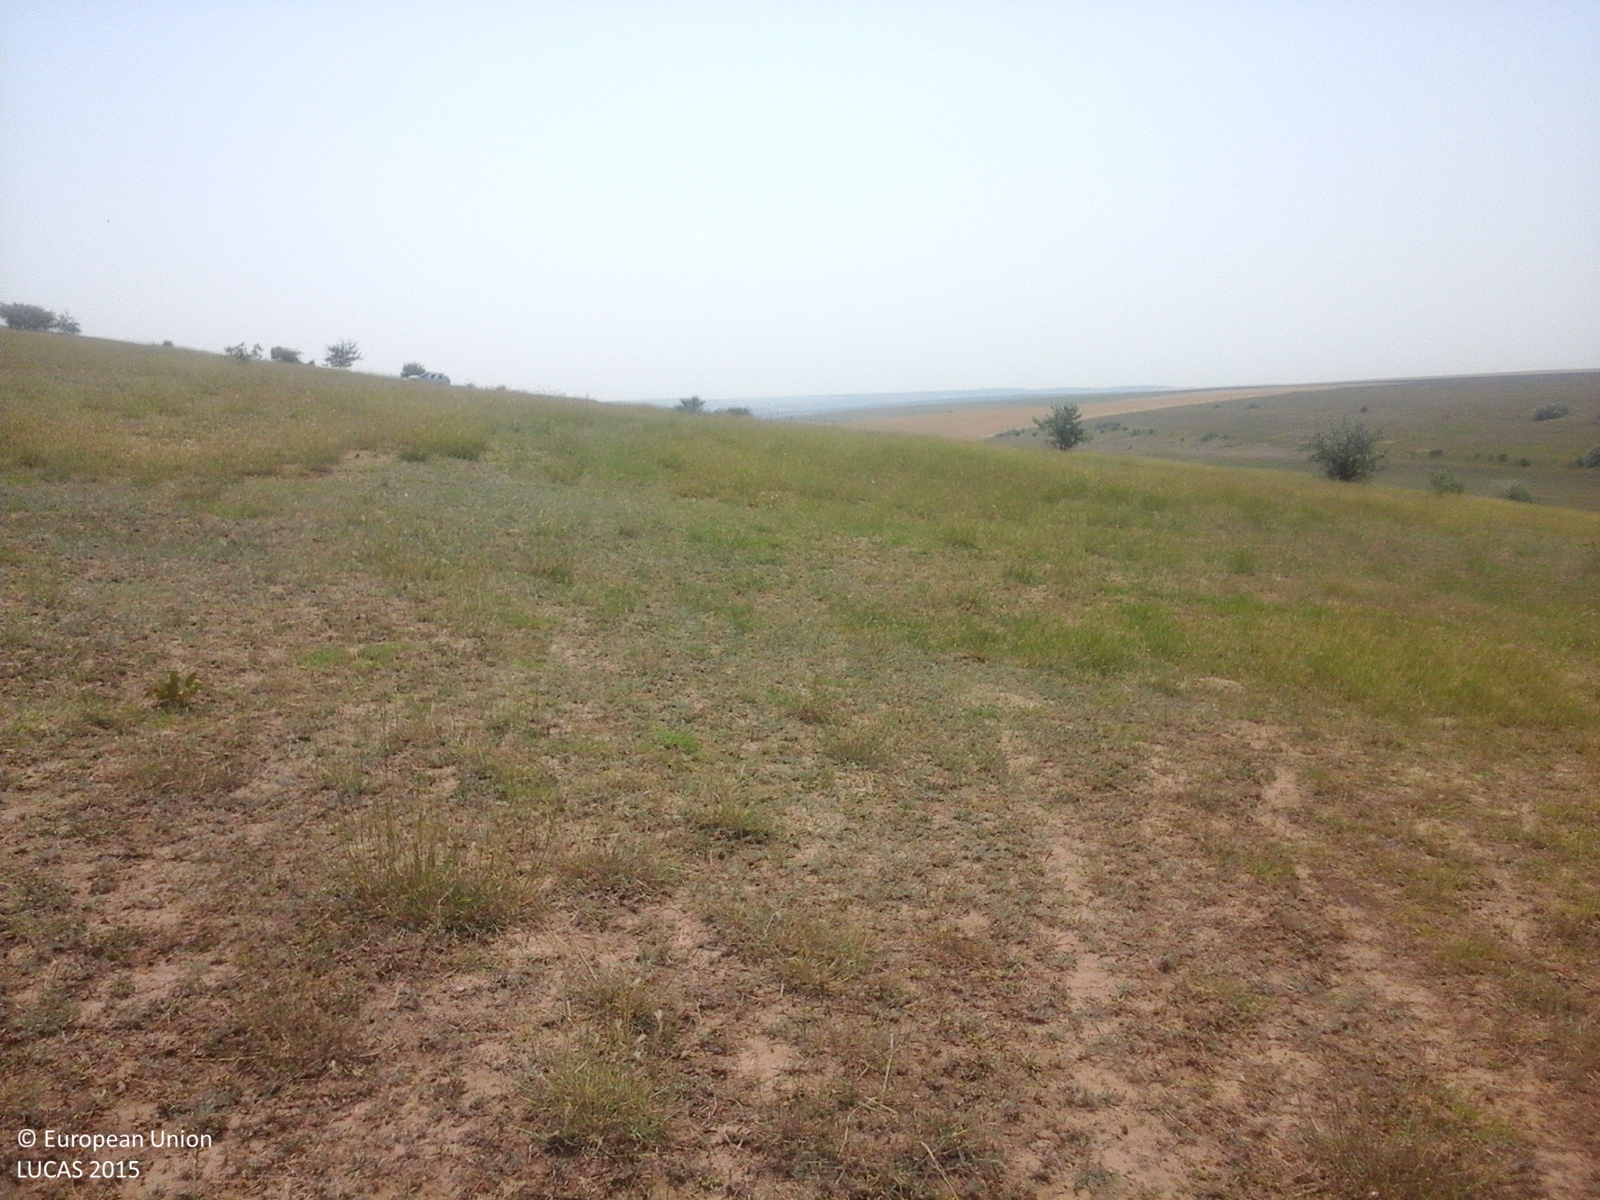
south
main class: Grassland
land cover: Grassland without tree/shrub cover
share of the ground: 50 - 75 %
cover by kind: herbaceous plants 100 %
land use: Agriculture (excluding fallow land and kitchen gardens)
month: July
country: RO
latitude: 45.8830
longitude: 27.9662
